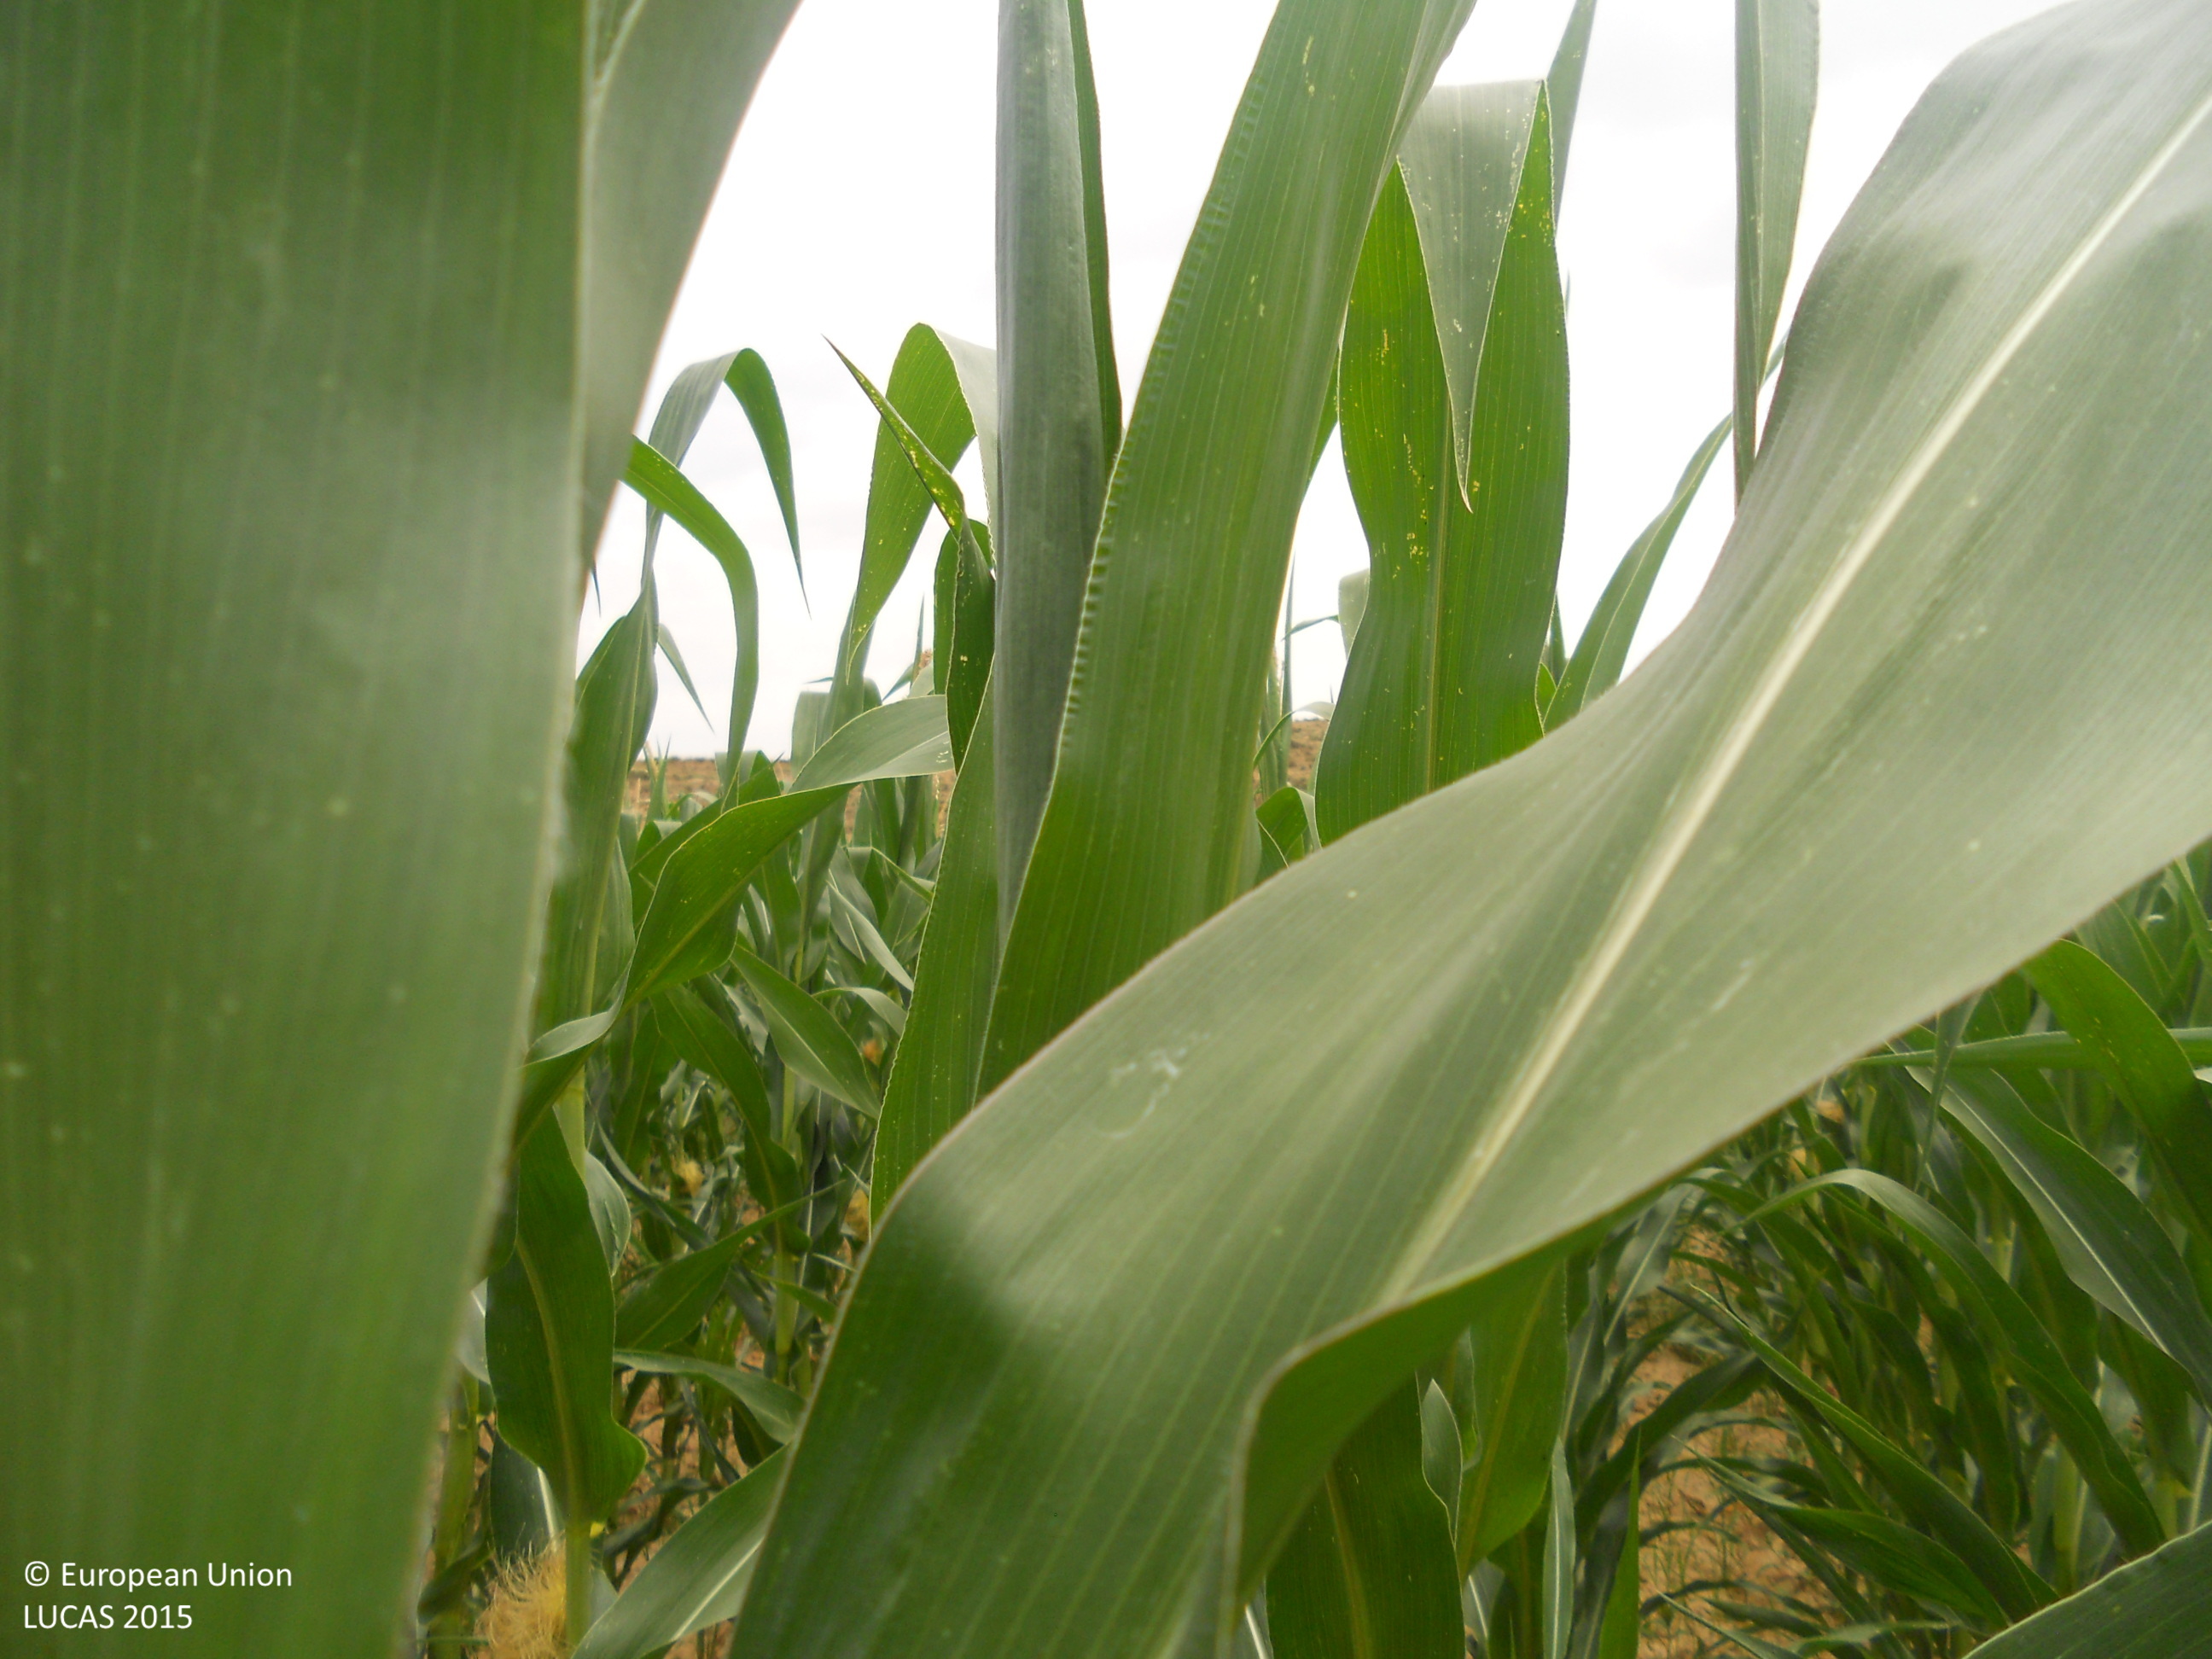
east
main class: Cropland
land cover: Maize
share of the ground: > 75 %
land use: Agriculture (excluding fallow land and kitchen gardens)
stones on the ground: < 10 %
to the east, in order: Maize; Ditches and canals; Grass margins; Paved roads, cycling and walking lanes; Inland fresh running water; Grassland without tree/shrub cover; Tracks; Grassland with sparse tree/shrub cover; Shrubland without tree cover; Common wheat; Spontaneously vegetated surfaces; Shruby margins
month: July
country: ES
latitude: 42.5469
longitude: -5.4251
